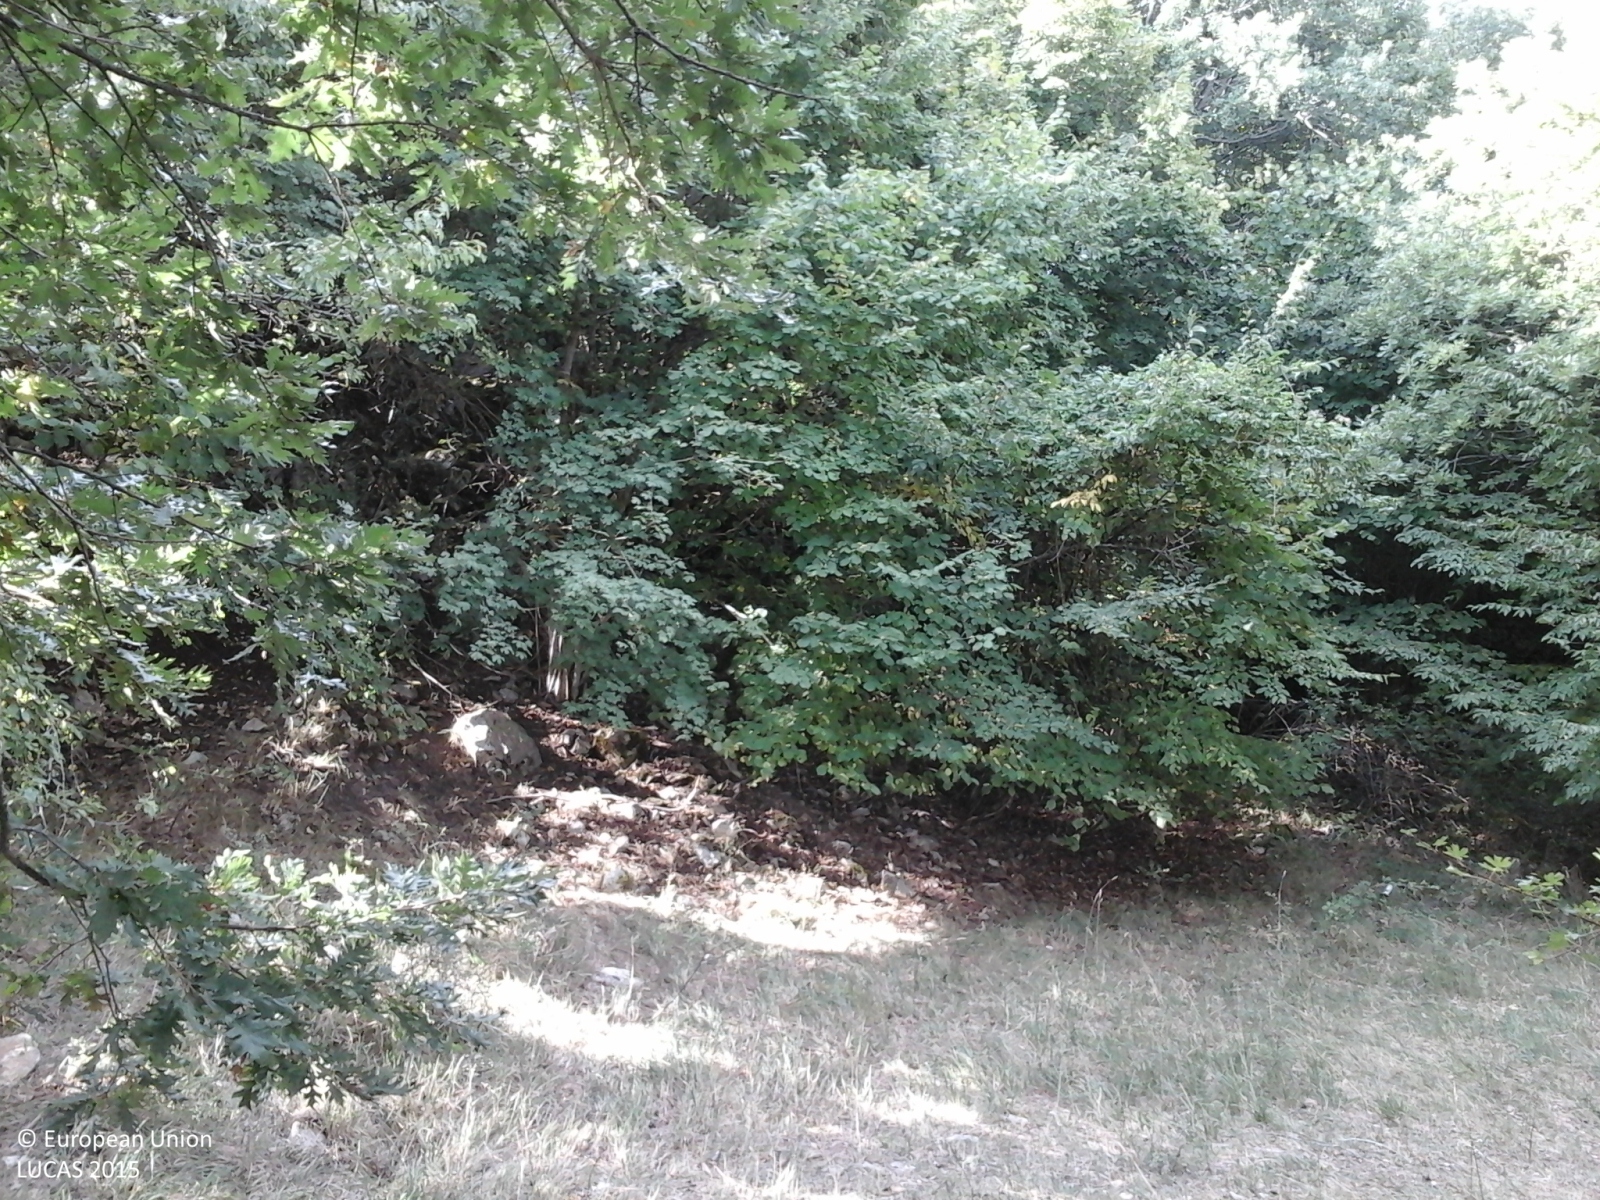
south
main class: Woodland
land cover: Broadleaved woodland
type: thermophilous deciduous forest
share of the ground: > 75 %
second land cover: Grassland without tree/shrub cover
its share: > 75 %
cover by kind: broadleaved forest trees 80 %, herbaceous plants 15 %, shrubs 5 %
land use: Forestry
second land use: Agriculture (excluding fallow land and kitchen gardens)
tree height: > 5 m
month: September
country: IT
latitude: 41.6604
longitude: 14.2483
